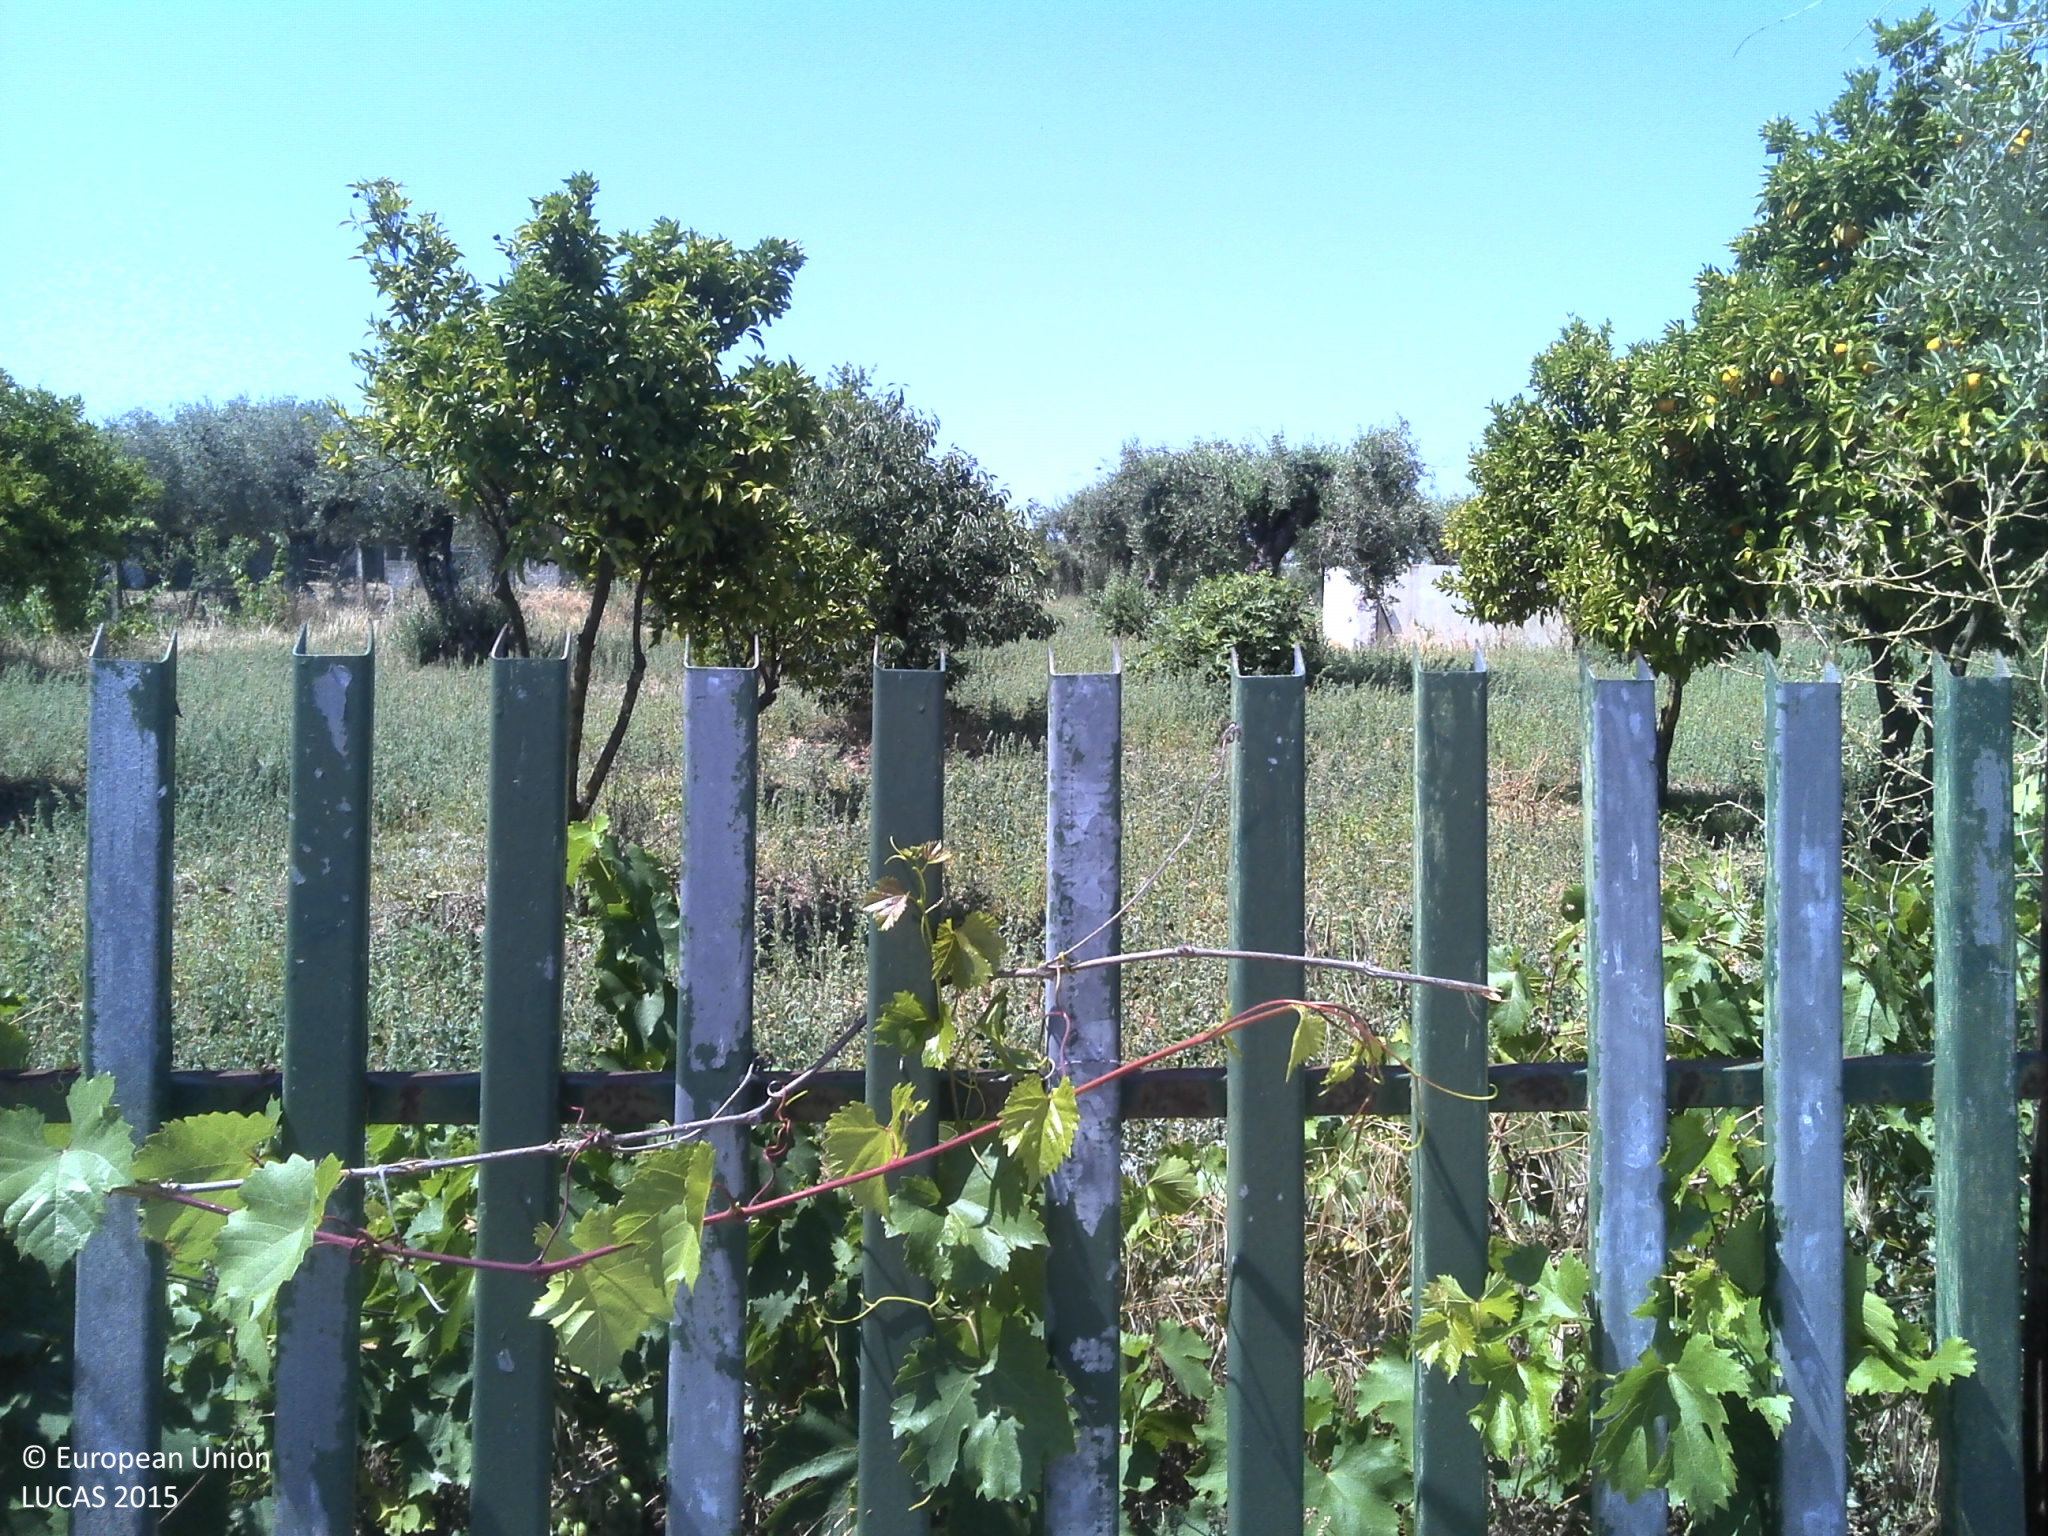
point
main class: Cropland
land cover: Olive groves
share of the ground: 25 - 50 %
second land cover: Grassland without tree/shrub cover
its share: 25 - 50 %
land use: Agriculture (excluding fallow land and kitchen gardens)
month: June
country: PT
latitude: 39.8468
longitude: -7.0710
